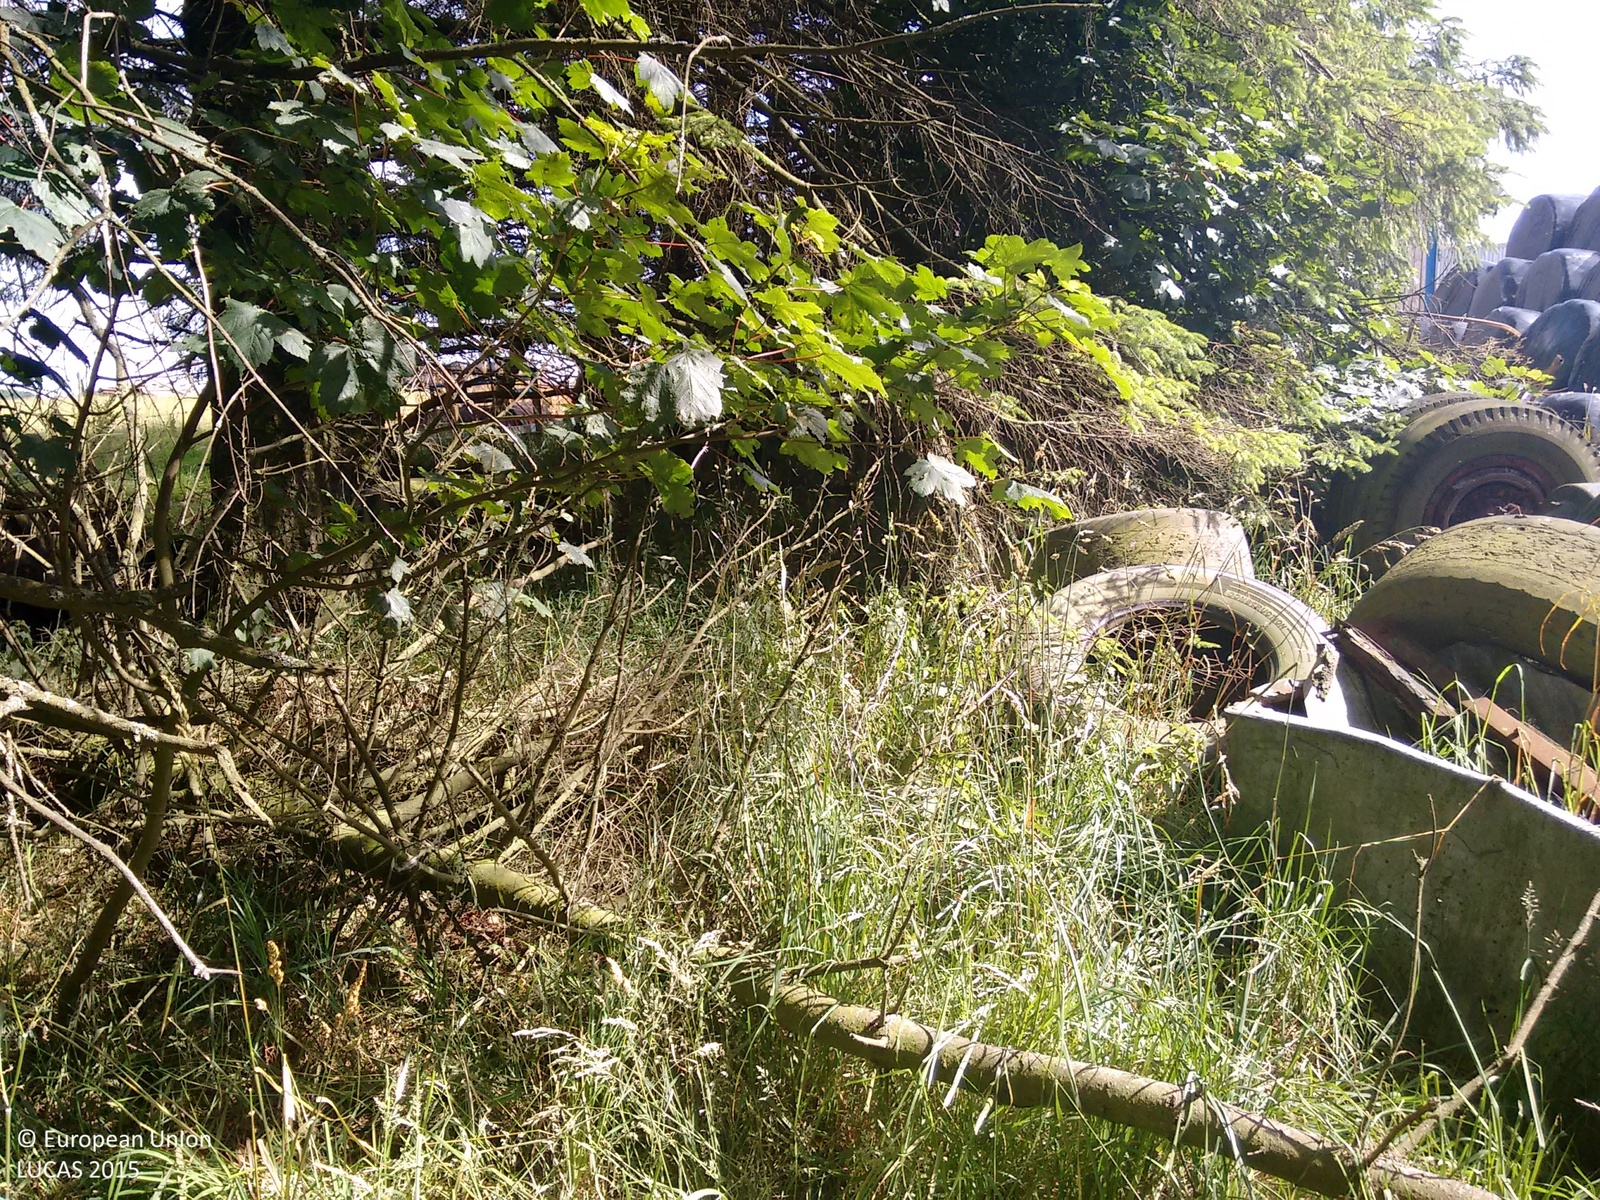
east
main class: Woodland
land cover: Spruce dominated coniferous woodland
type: exotic forest
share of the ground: > 75 %
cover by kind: coniferous forest trees 70 %, herbaceous plants 10 %, broadleaved forest trees 5 %, shrubs 5 %
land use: Agriculture (excluding fallow land and kitchen gardens)
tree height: > 5 m
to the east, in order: Spruce dominated coniferous woodland; Artificial constructions in urban areas; Grassland without tree/shrub cover; Fences; Electric lines; Grassland without tree/shrub cover
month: August
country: GB
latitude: 57.5679
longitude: -2.9838
